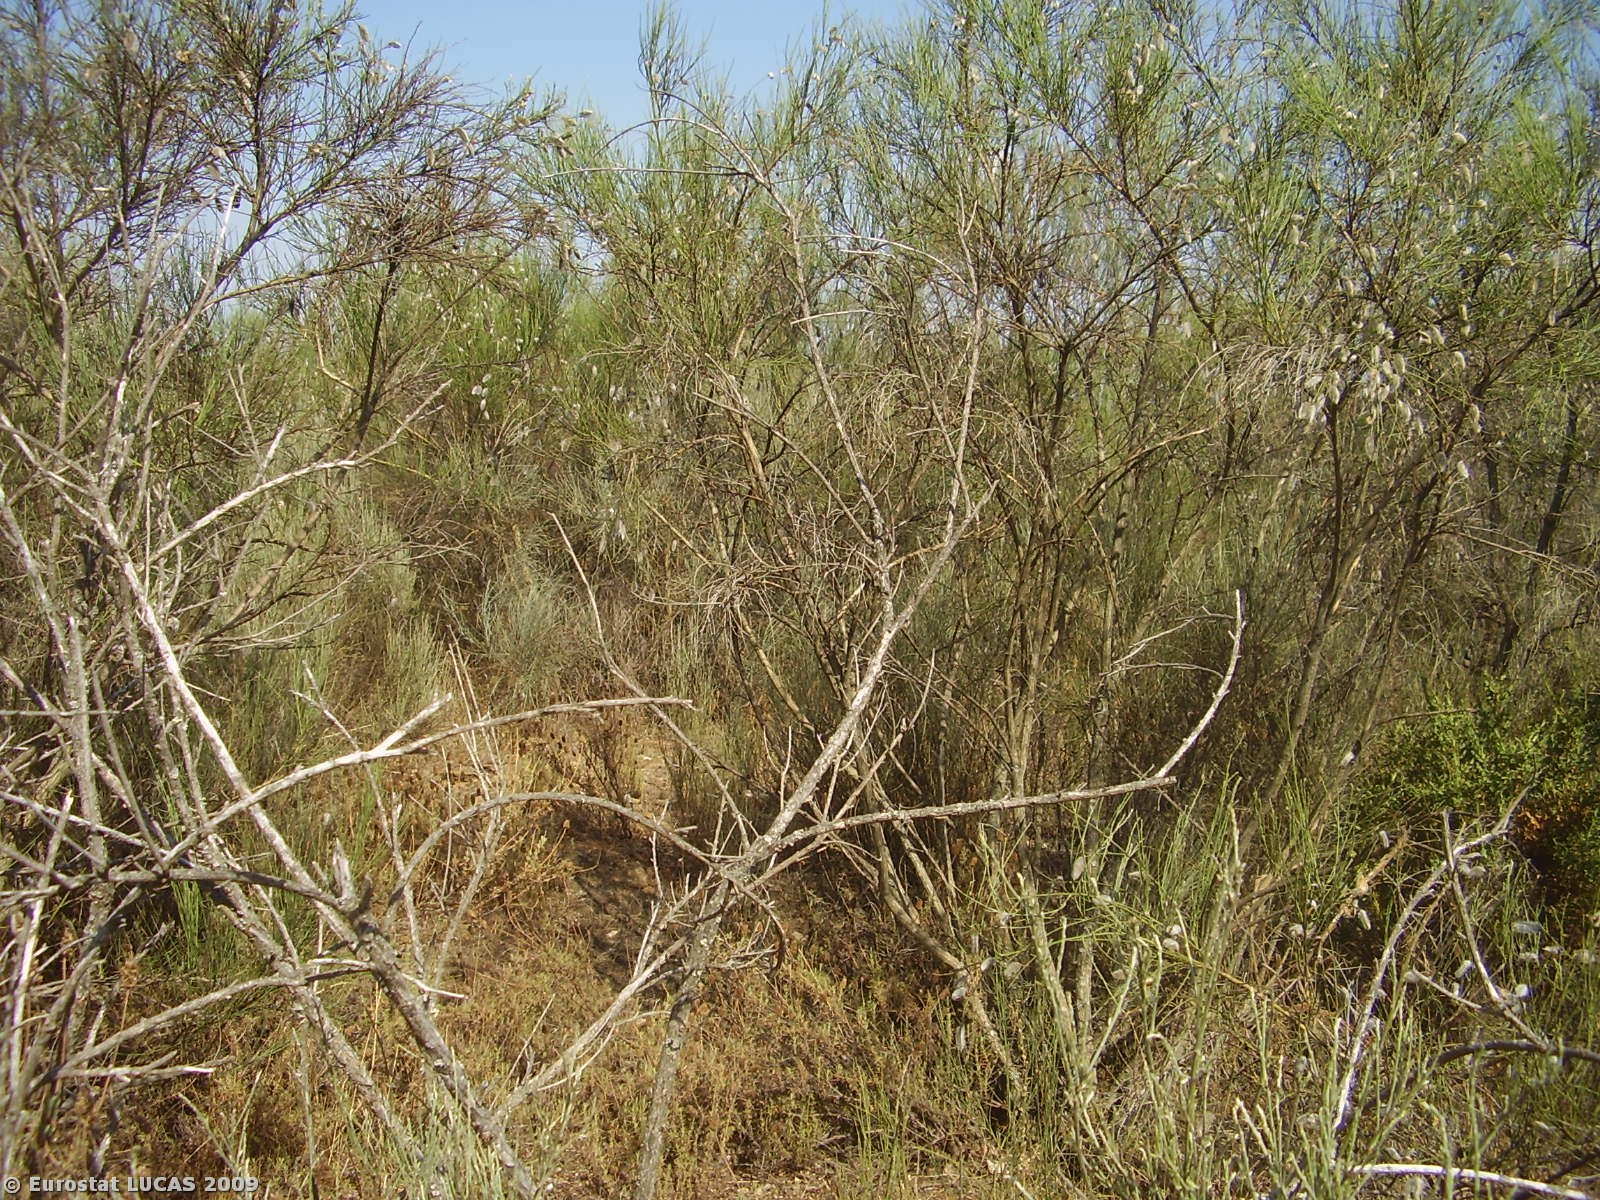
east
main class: Shrubland
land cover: Shrubland without tree cover
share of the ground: > 75 %
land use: Fallow land
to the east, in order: Shrubland without tree cover; Shrubland with sparse tree cover; Broadleaved woodland; Tracks; Olive groves; Ditches and canals; Bare land
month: August
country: PT
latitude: 41.3909
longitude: -6.9873
